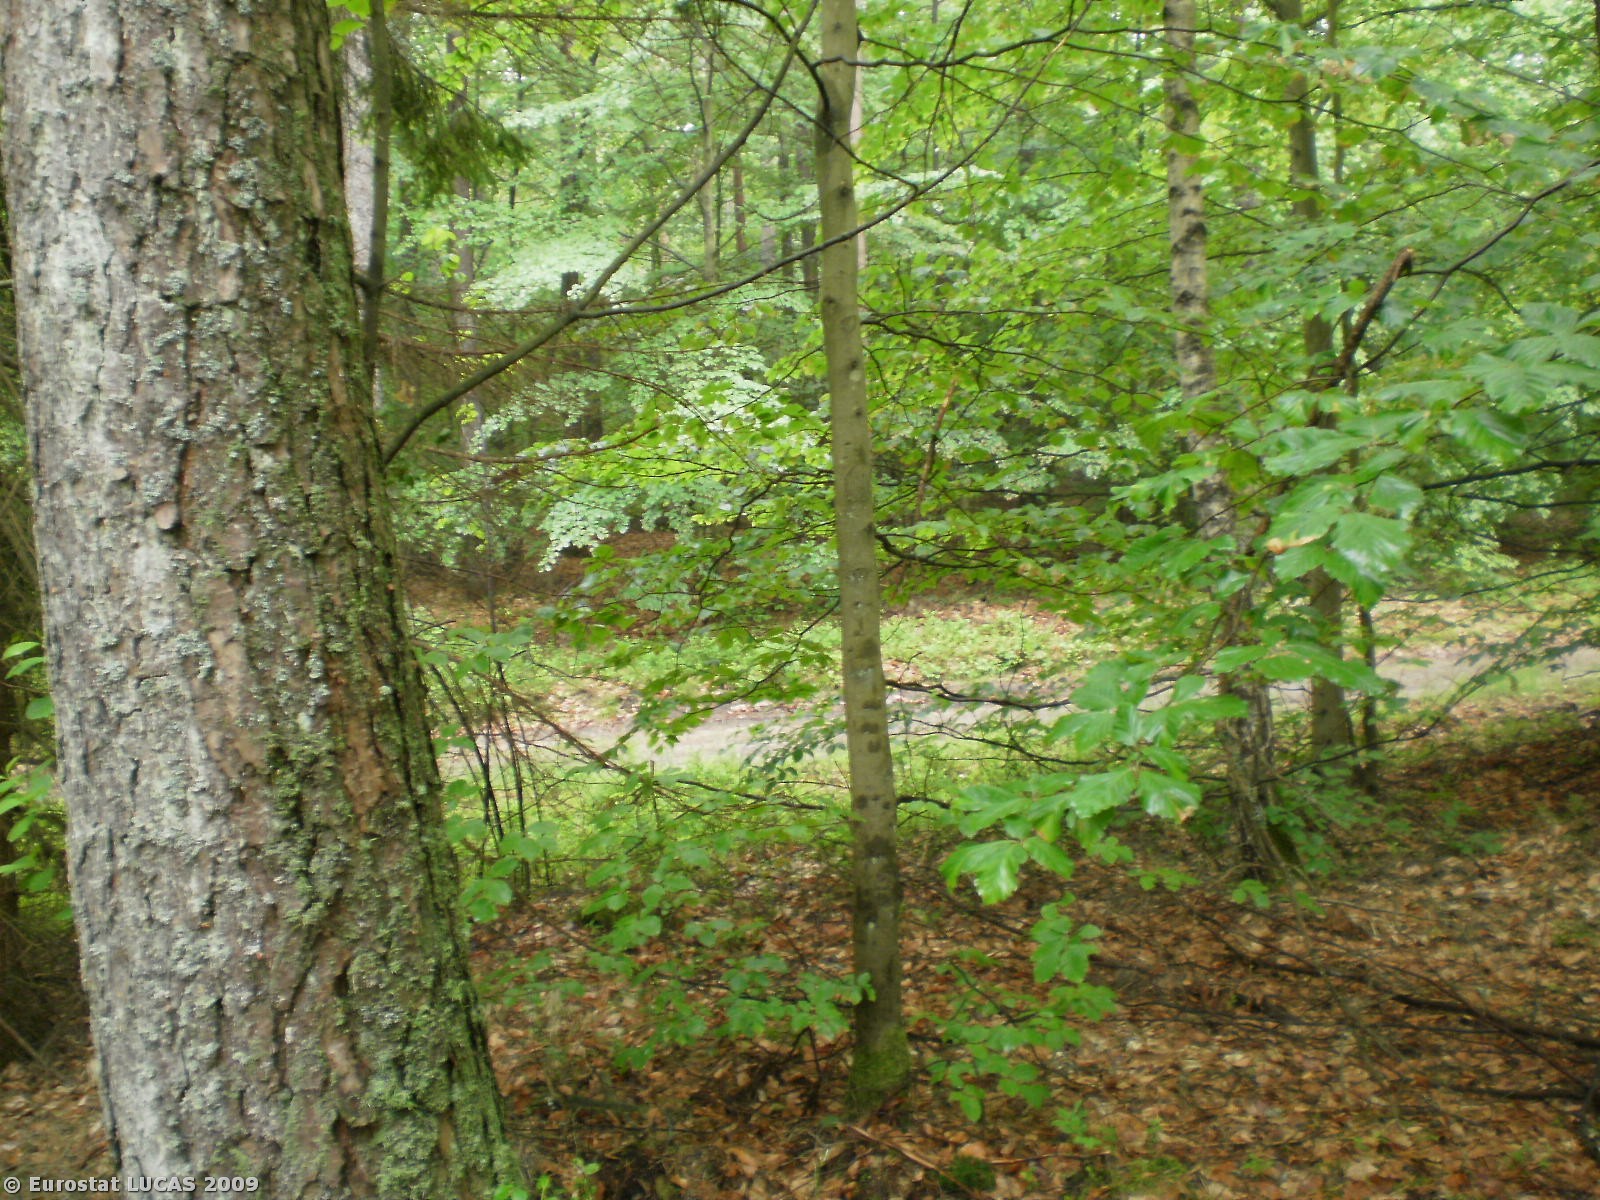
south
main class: Woodland
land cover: Mixed woodland
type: hemiboreal forest and nemoral coniferous forest and mixed broadleaved-coniferous forest
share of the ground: > 75 %
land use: Forestry
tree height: > 5 m
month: June
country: PL
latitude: 54.5539
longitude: 17.8826
